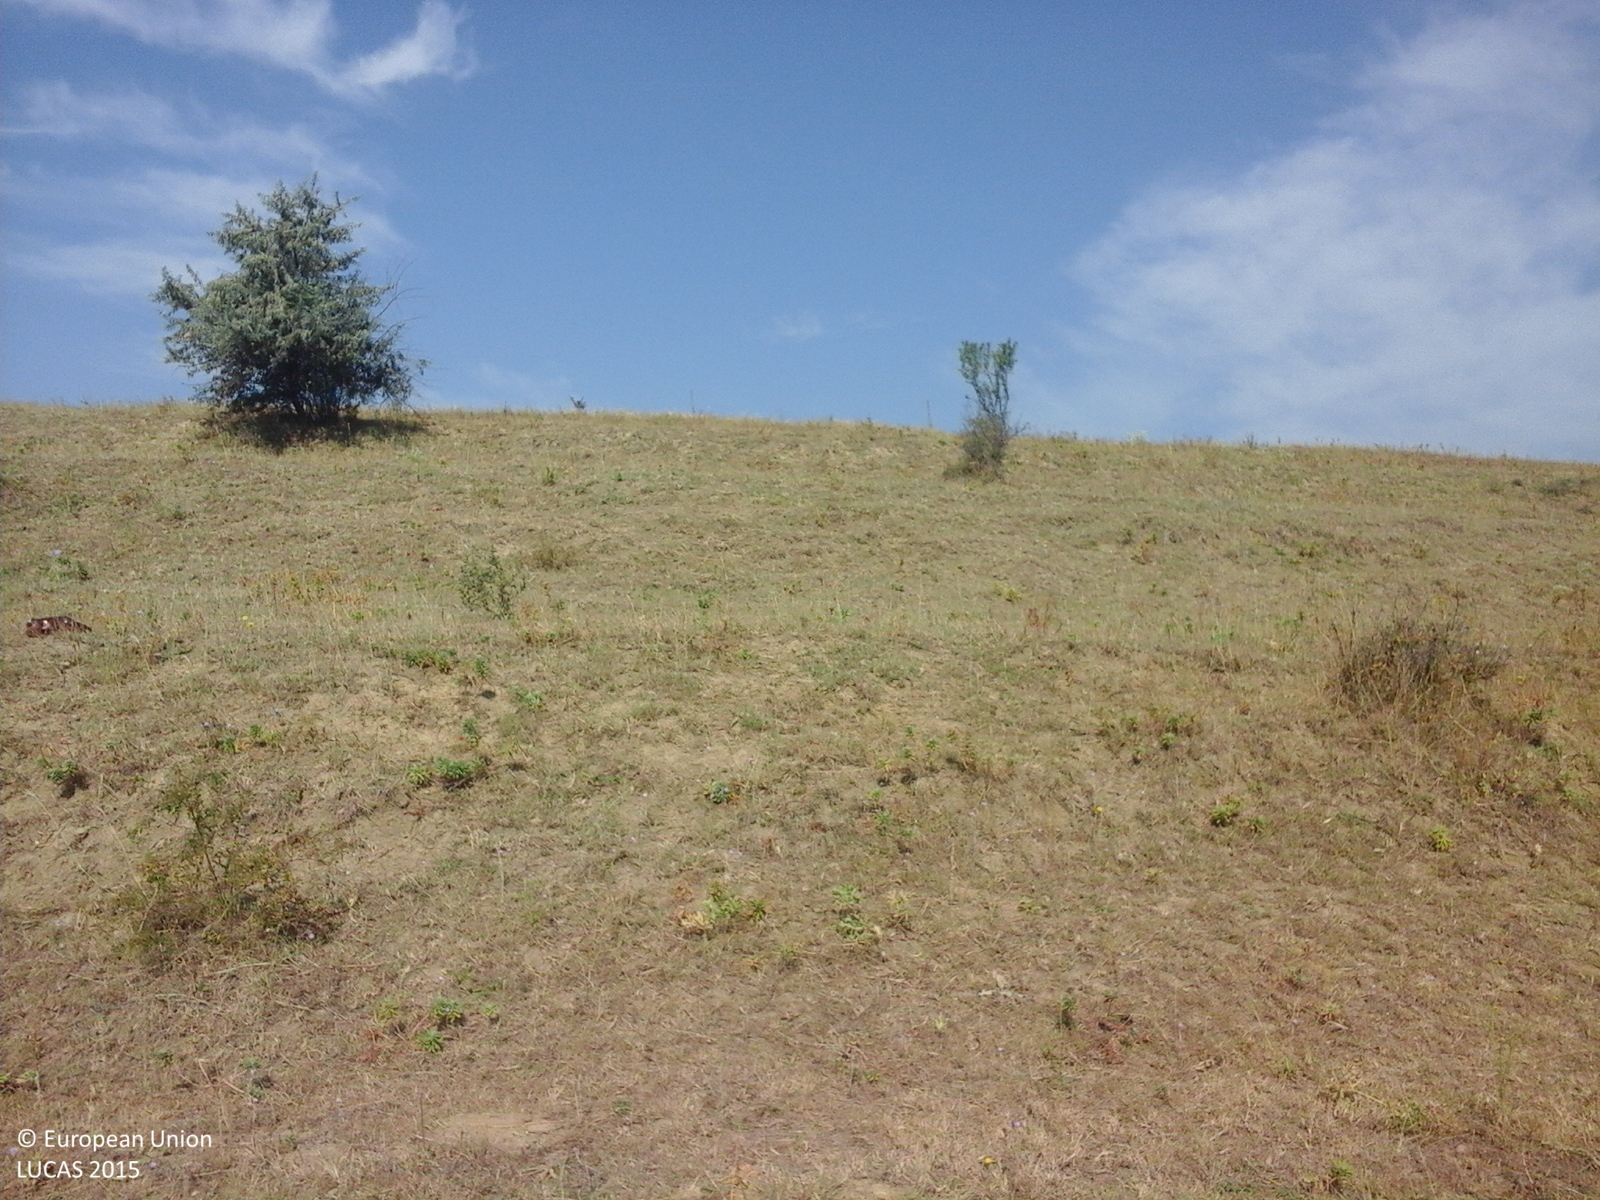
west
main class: Grassland
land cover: Grassland with sparse tree/shrub cover
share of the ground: > 75 %
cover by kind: herbaceous plants 85 %, shrubs 10 %, broadleaved forest trees 5 %
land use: Agriculture (excluding fallow land and kitchen gardens)
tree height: < 5 m
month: July
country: RO
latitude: 46.5661
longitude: 28.1754
